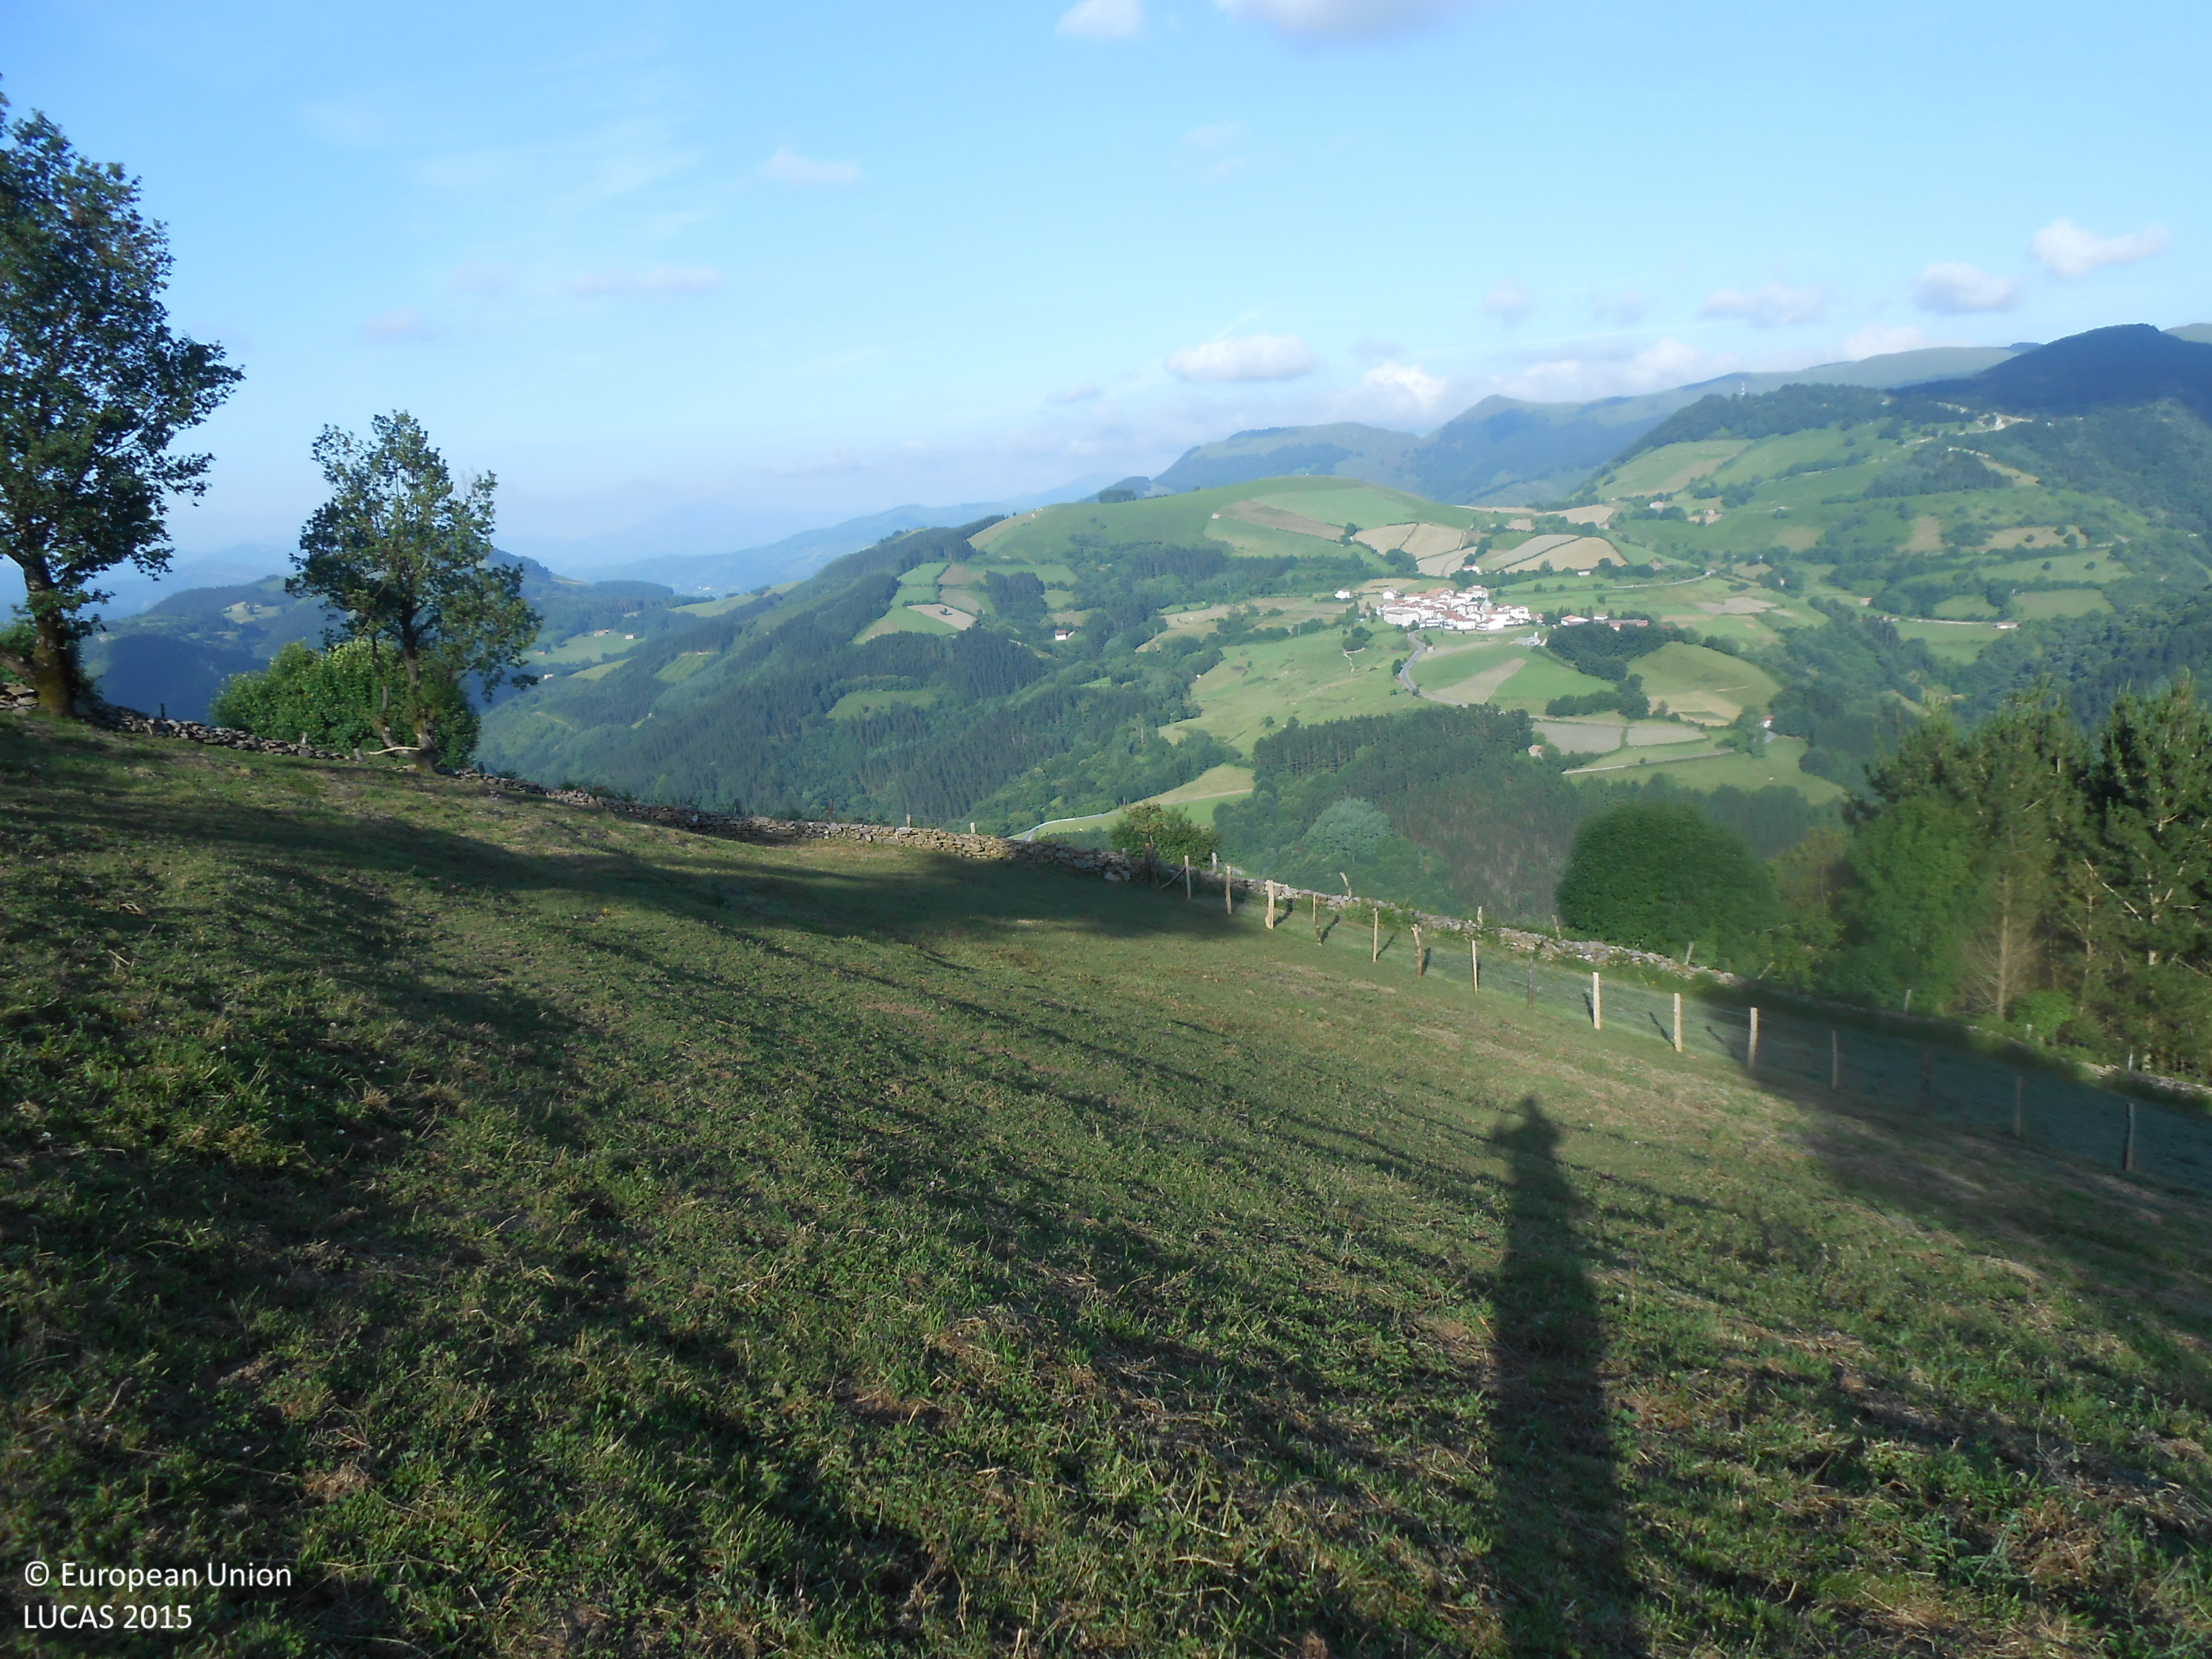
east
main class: Grassland
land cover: Grassland without tree/shrub cover
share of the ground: > 75 %
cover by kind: herbaceous plants 100 %
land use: Agriculture (excluding fallow land and kitchen gardens)
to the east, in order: Grassland without tree/shrub cover; Dry stone walls; Grassland without tree/shrub cover; Tracks; Grassland without tree/shrub cover; Fences; Grassland without tree/shrub cover; Fences; Grassland without tree/shrub cover; Fences; Shrubland without tree cover; Paved roads, cycling and walking lanes; Single bushes/trees; Other coniferous woodland; Grassland without tree/shrub cover; Paved roads, cycling and walking lanes; Grass margins; Fences; Broadleaved woodland
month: June
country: ES
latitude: 43.0918
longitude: -1.7999
